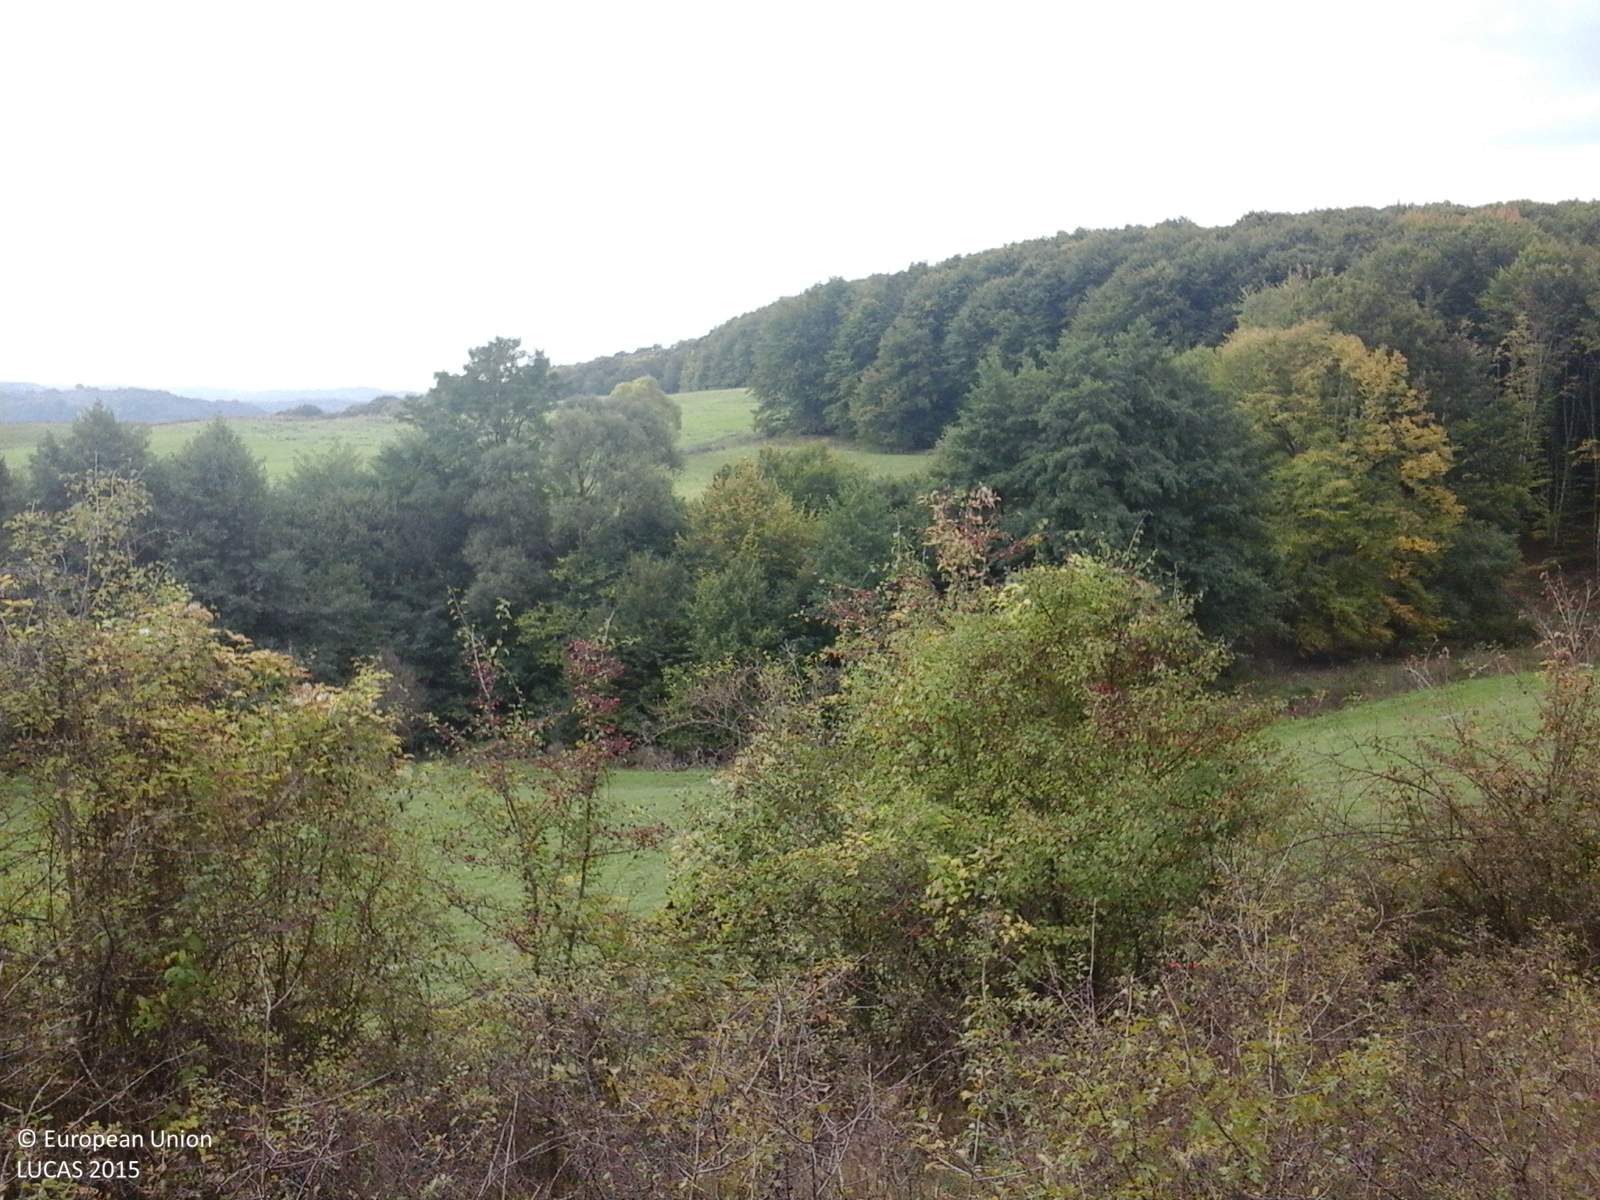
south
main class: Shrubland
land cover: Shrubland without tree cover
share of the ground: > 75 %
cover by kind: shrubs 100 %
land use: Semi-natural and natural areas not in use
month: October
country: RO
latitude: 46.4957
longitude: 24.9896
